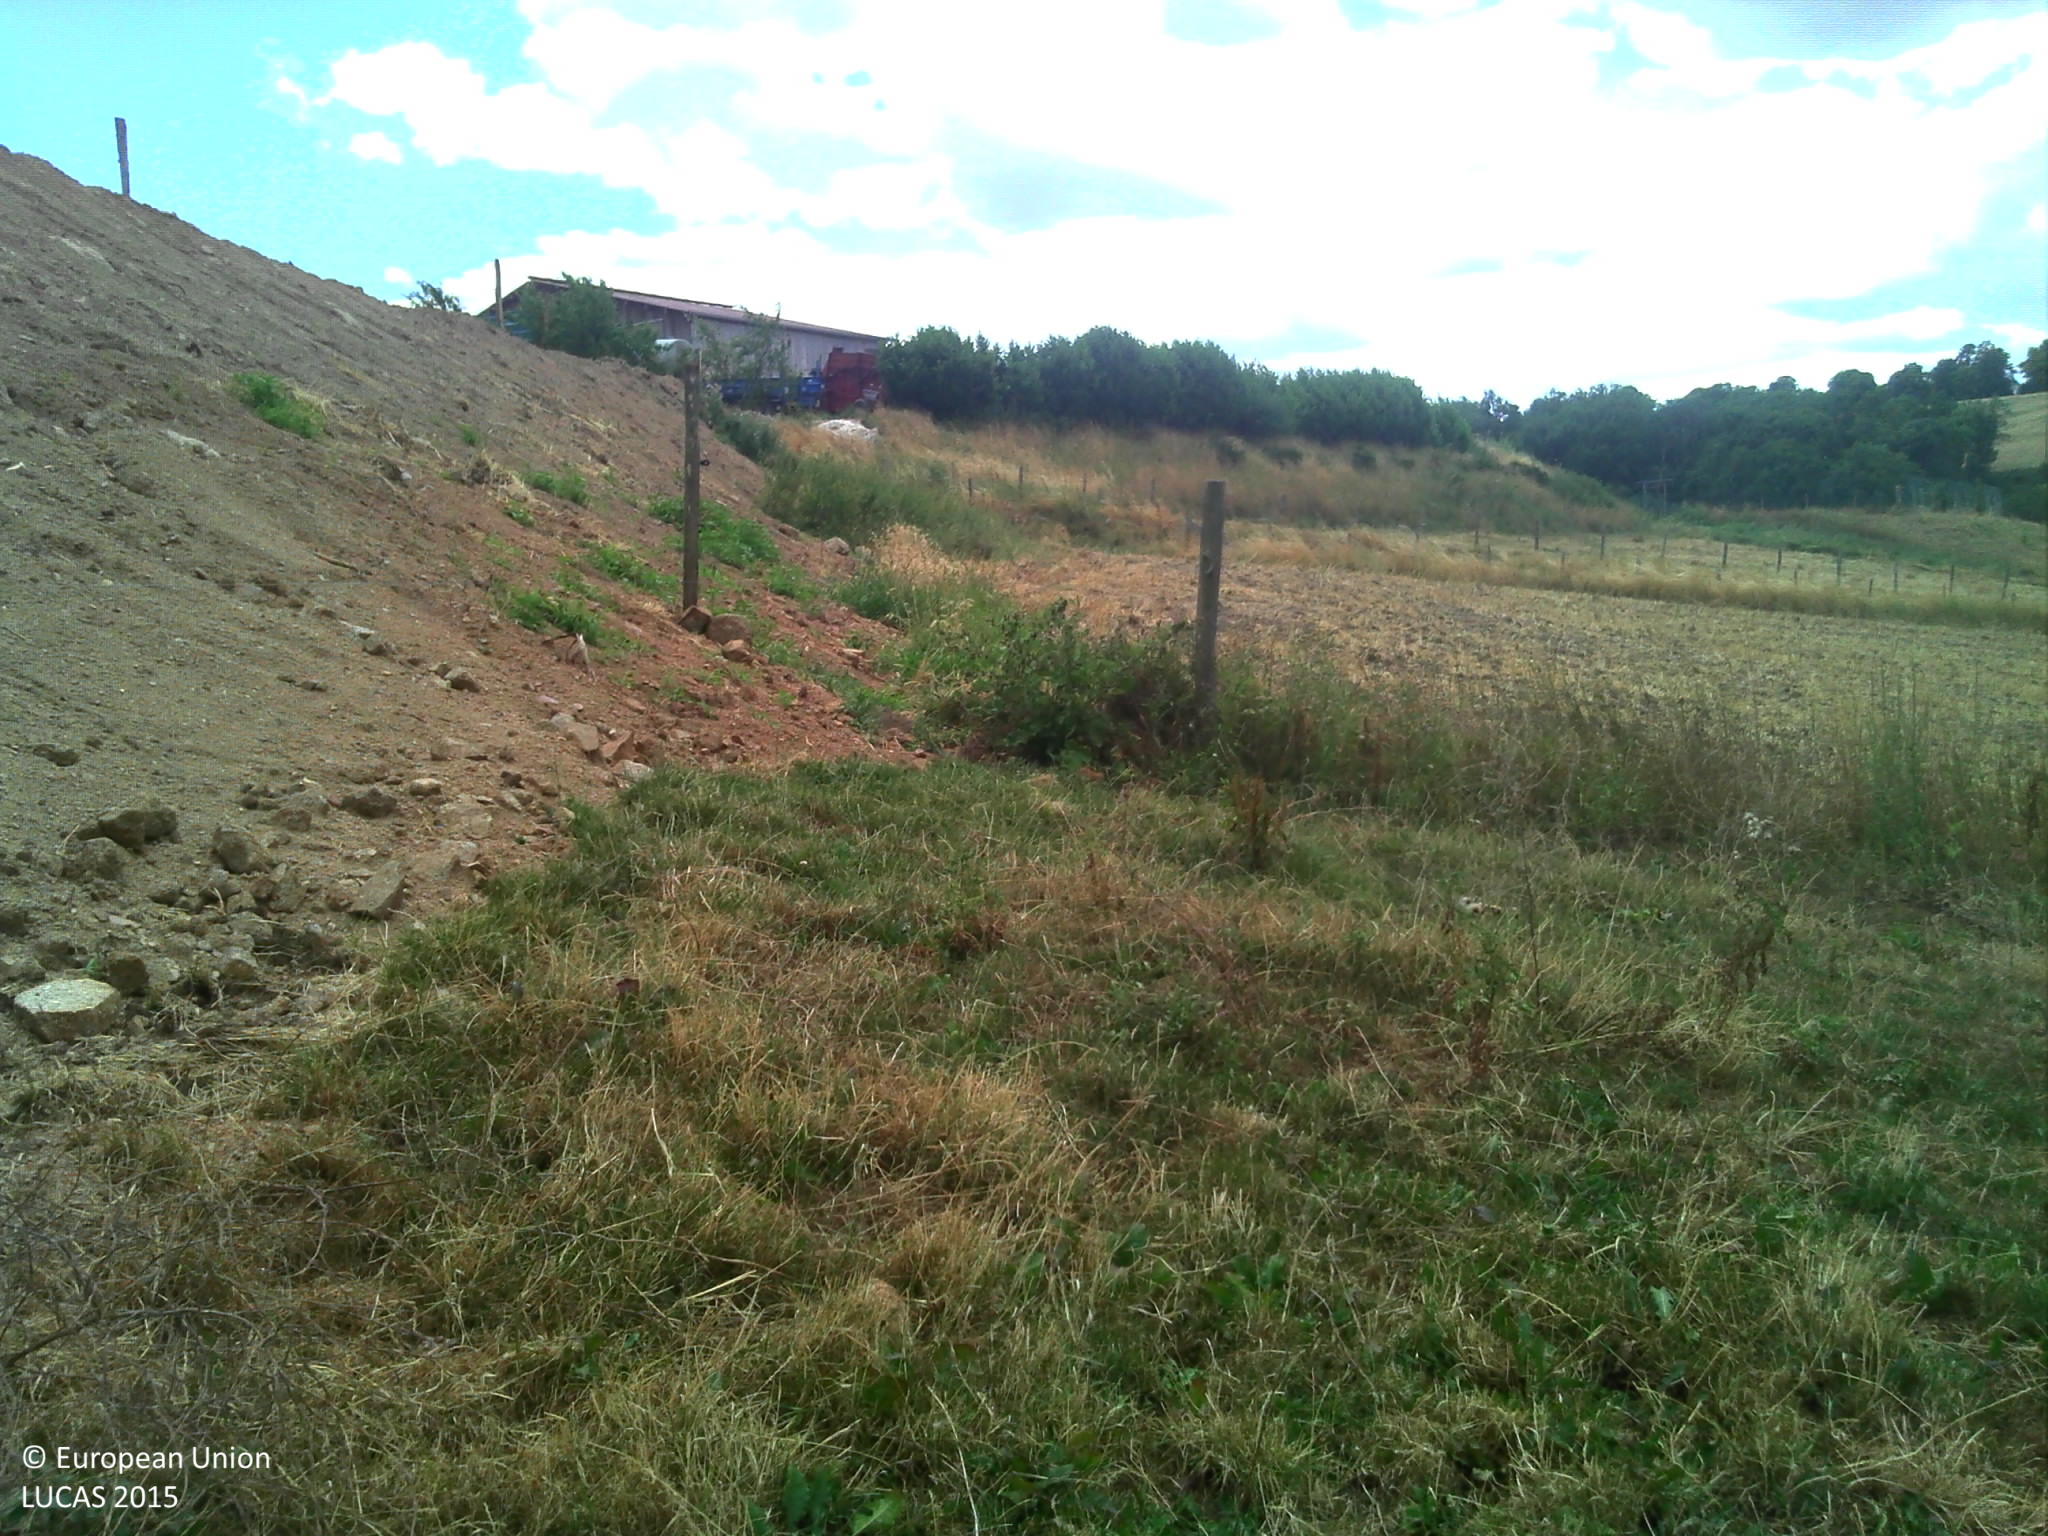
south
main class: Grassland
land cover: Grassland without tree/shrub cover
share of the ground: > 75 %
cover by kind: herbaceous plants 100 %
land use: Agriculture (excluding fallow land and kitchen gardens)
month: July
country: FR
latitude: 45.7564
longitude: 4.4621
